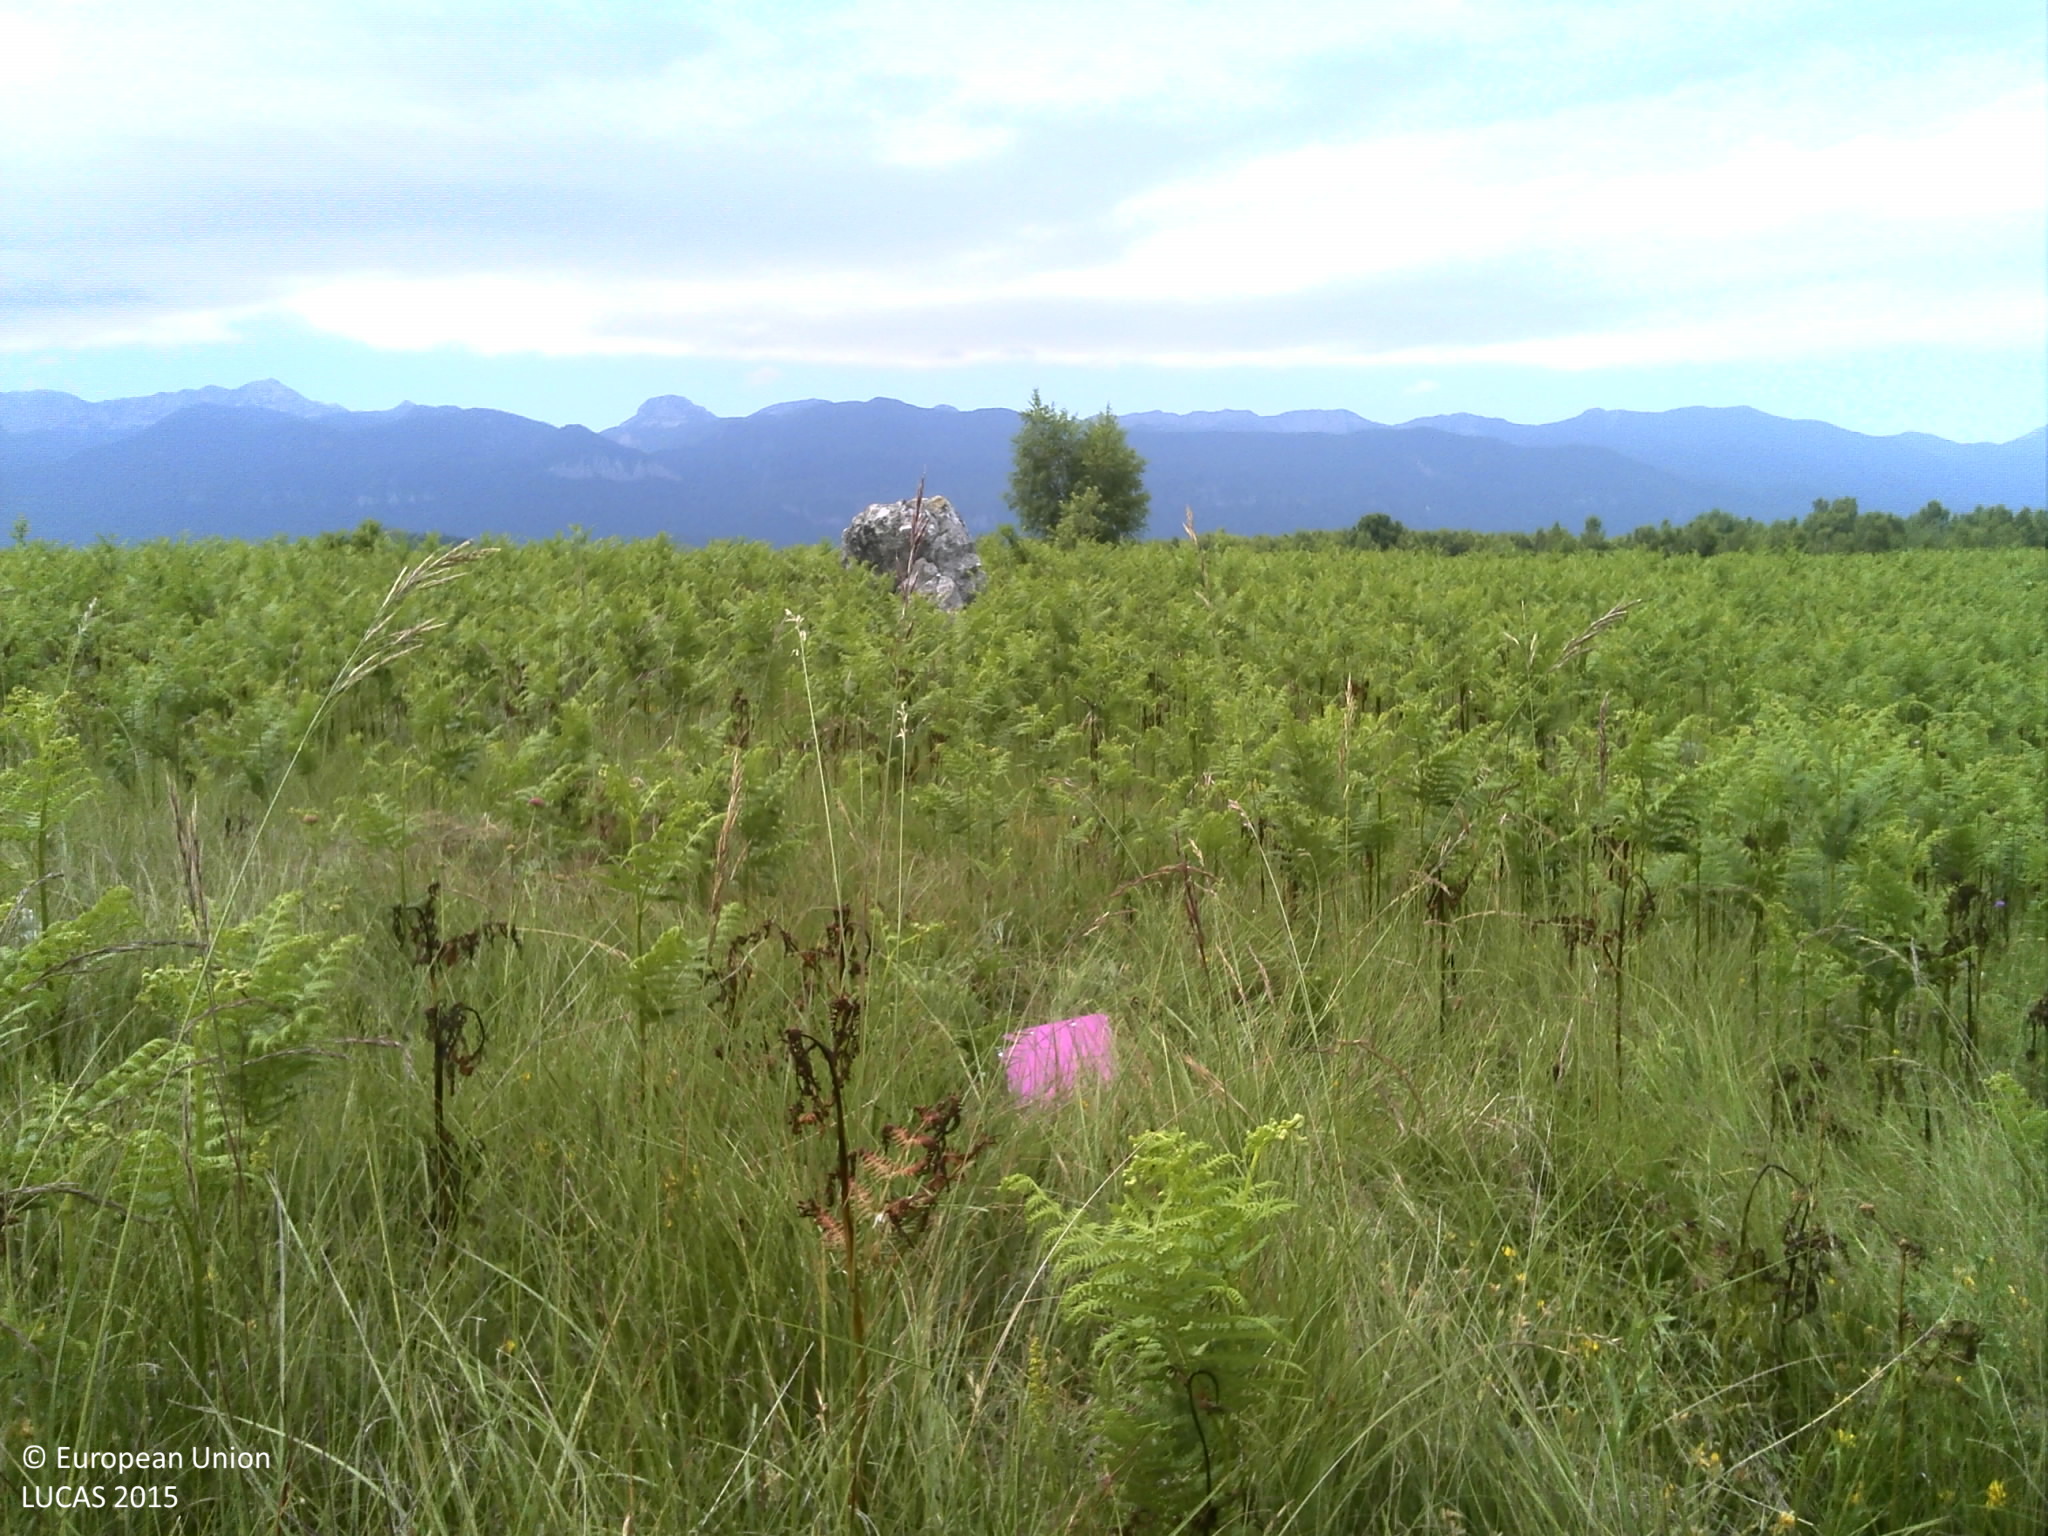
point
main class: Grassland
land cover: Spontaneously vegetated surfaces
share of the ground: > 75 %
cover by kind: herbaceous plants 90 %, shrubs 5 %, consolidated bare surface 5 %
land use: Semi-natural and natural areas not in use
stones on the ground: < 10 %
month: June
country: HR
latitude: 44.4738
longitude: 15.5372
